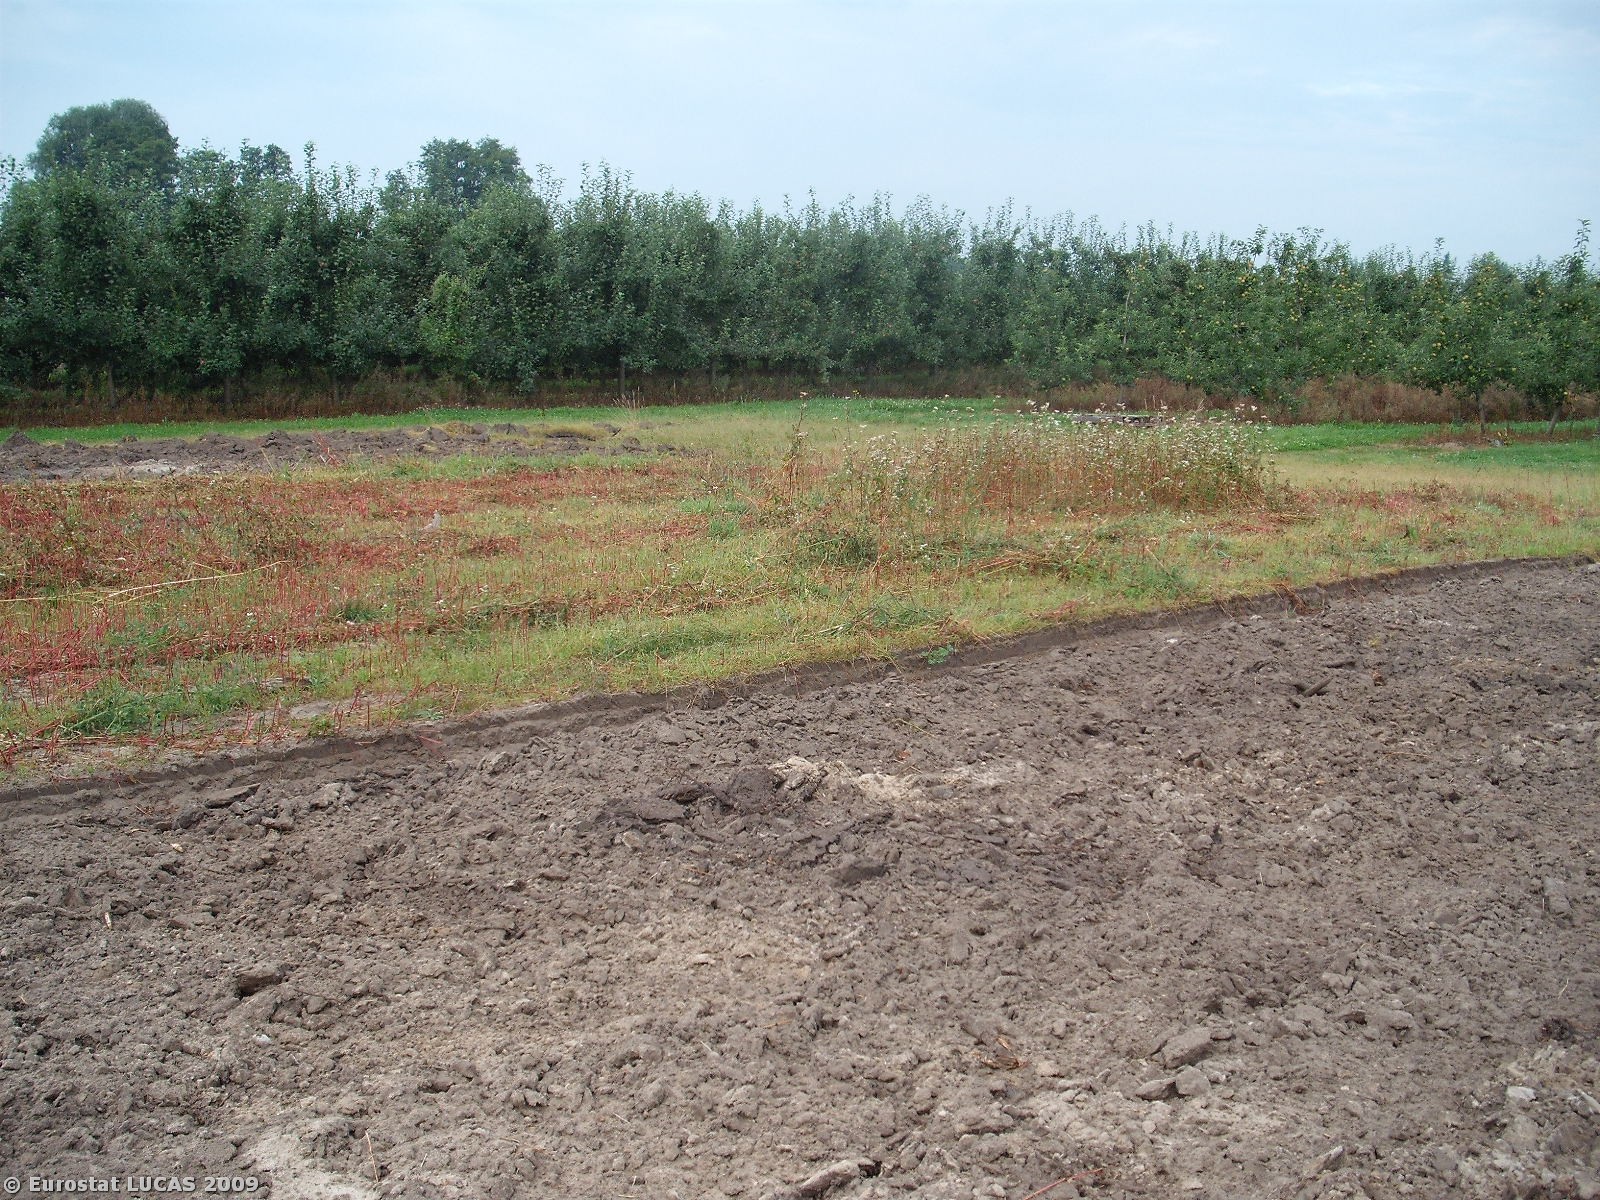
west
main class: Cropland
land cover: Apple fruit
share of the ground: 50 - 75 %
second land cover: Grassland with sparse tree/shrub cover
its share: > 75 %
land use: Agriculture (excluding fallow land and kitchen gardens)
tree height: < 5 m
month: August
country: PL
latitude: 51.7615
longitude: 21.1301
